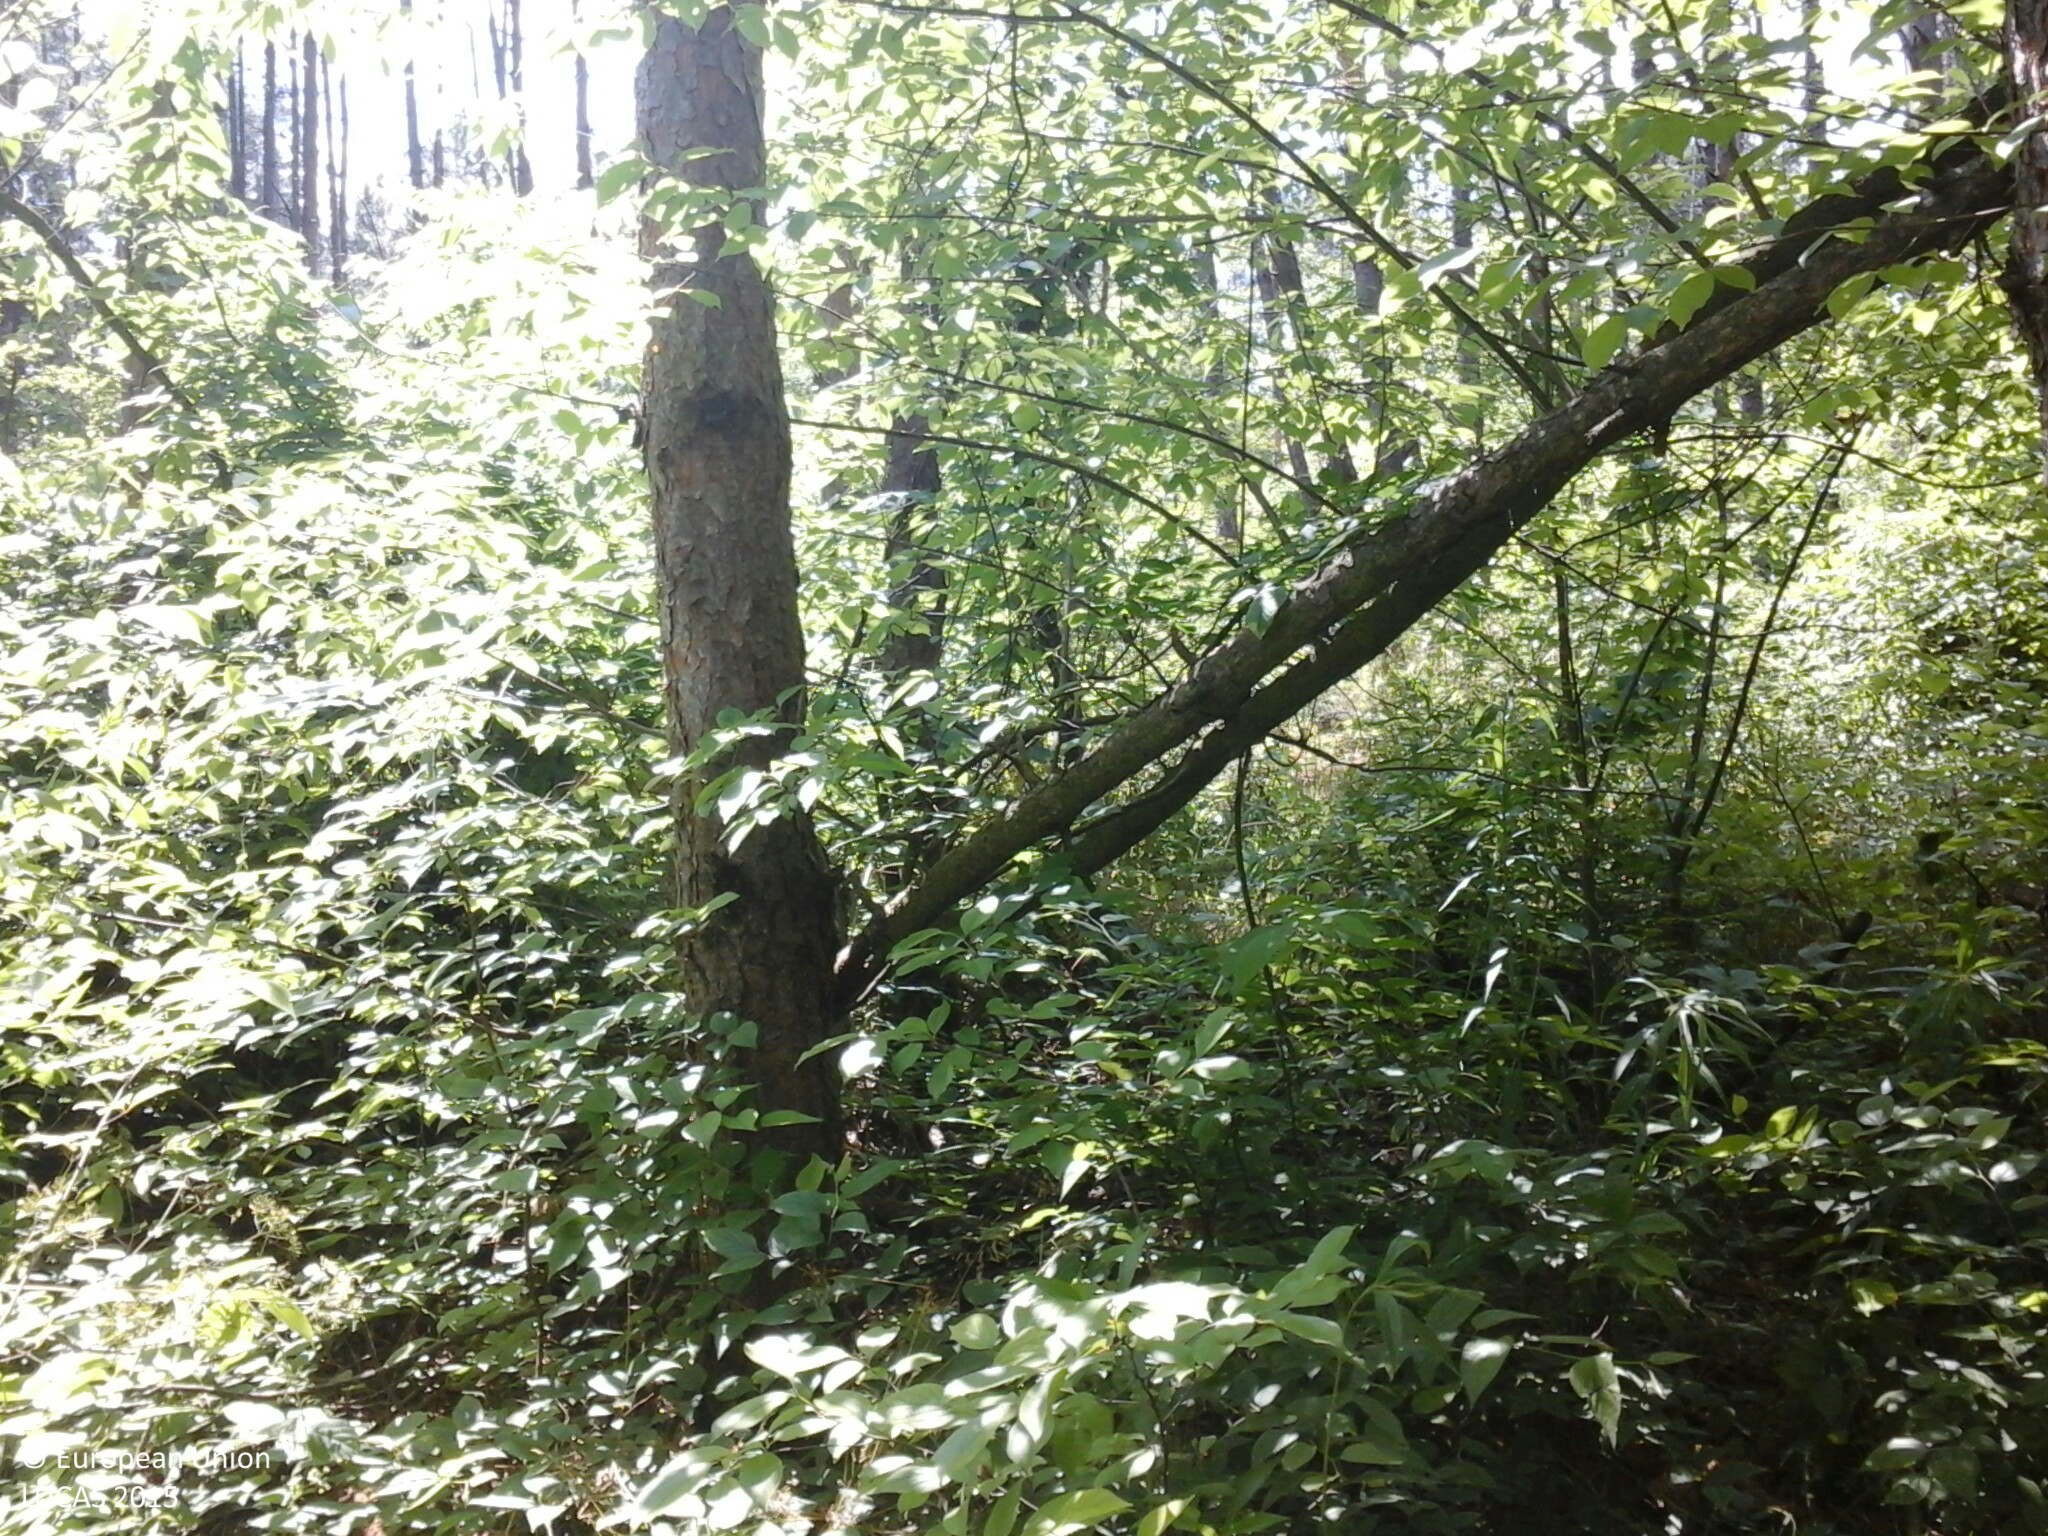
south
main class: Woodland
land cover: Pine dominated coniferous woodland
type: hemiboreal forest and nemoral coniferous forest and mixed broadleaved-coniferous forest
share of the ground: > 75 %
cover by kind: coniferous forest trees 95 %, broadleaved forest trees 5 %
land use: Forestry
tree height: > 5 m
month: June
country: HU
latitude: 47.6372
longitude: 19.4314
